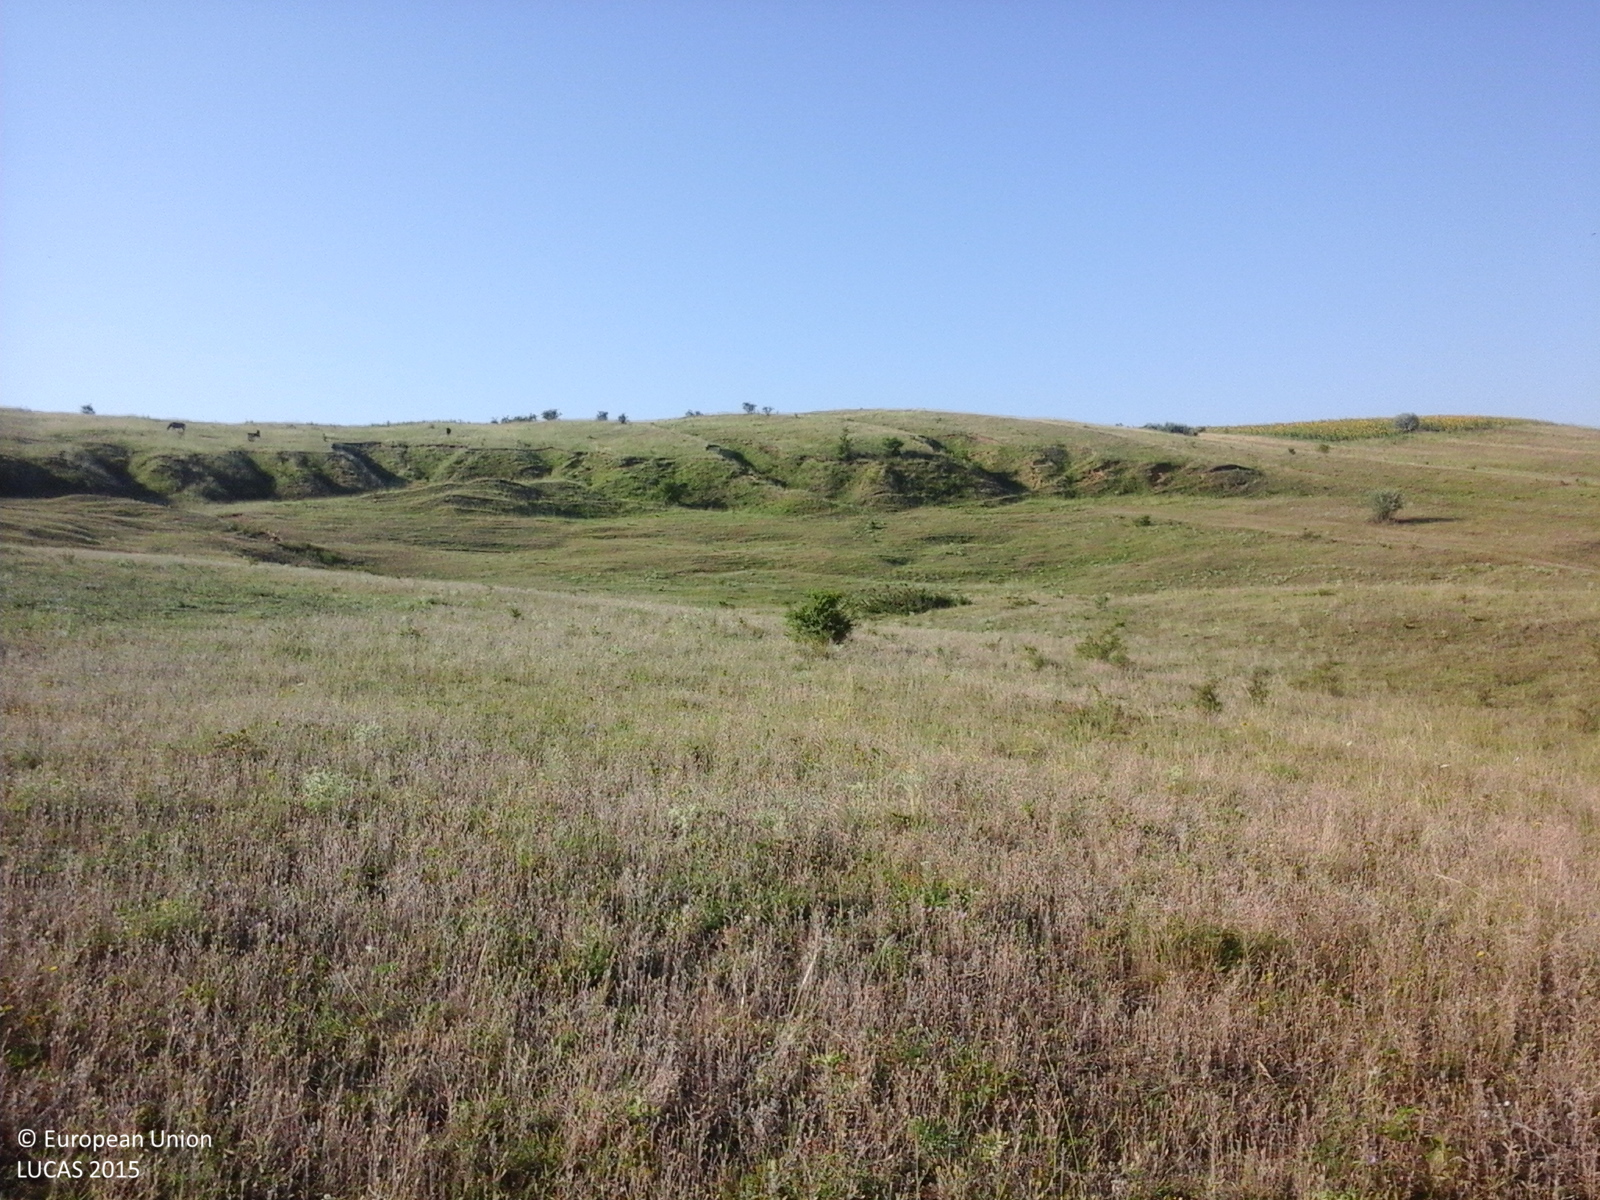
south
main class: Grassland
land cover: Grassland without tree/shrub cover
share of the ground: > 75 %
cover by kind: herbaceous plants 100 %
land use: Agriculture (excluding fallow land and kitchen gardens)
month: July
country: RO
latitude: 46.1959
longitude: 27.7522
